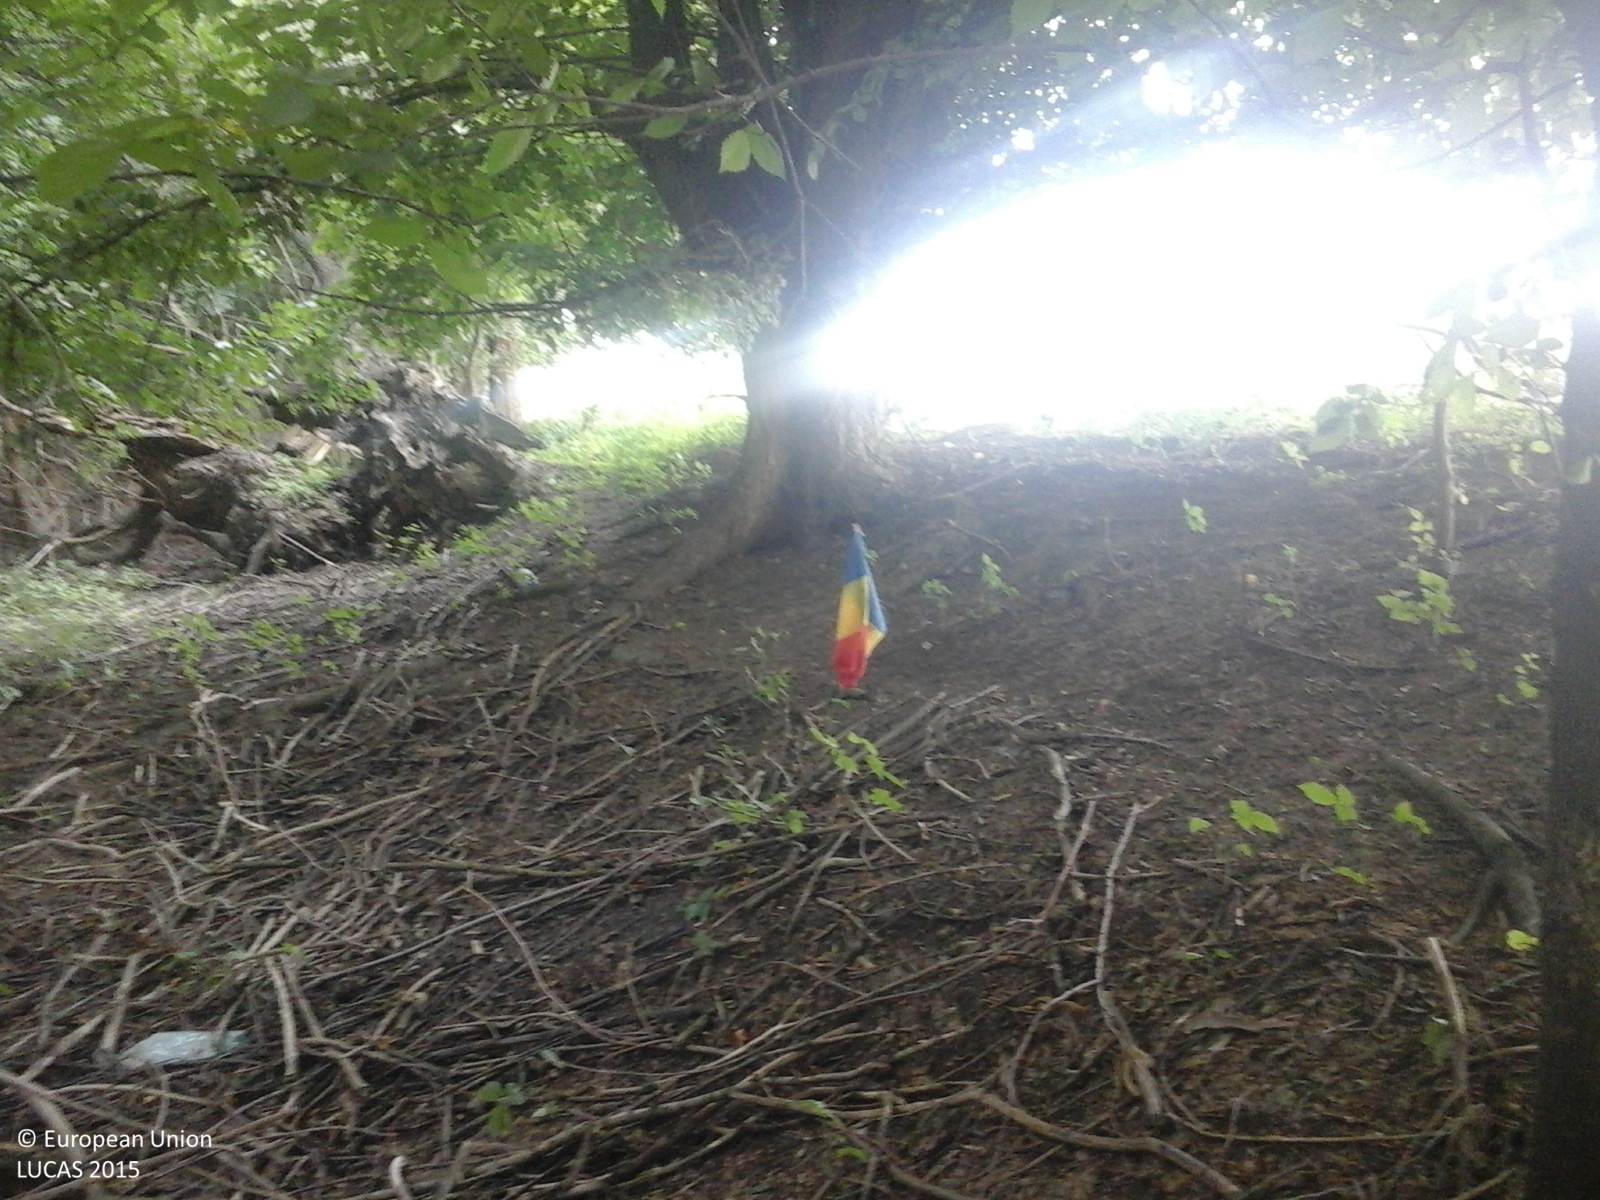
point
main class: Woodland
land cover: Broadleaved woodland
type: floodplain forest
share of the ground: > 75 %
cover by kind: broadleaved forest trees 100 %
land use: Forestry
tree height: > 5 m
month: August
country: RO
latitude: 44.2364
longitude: 27.8933
